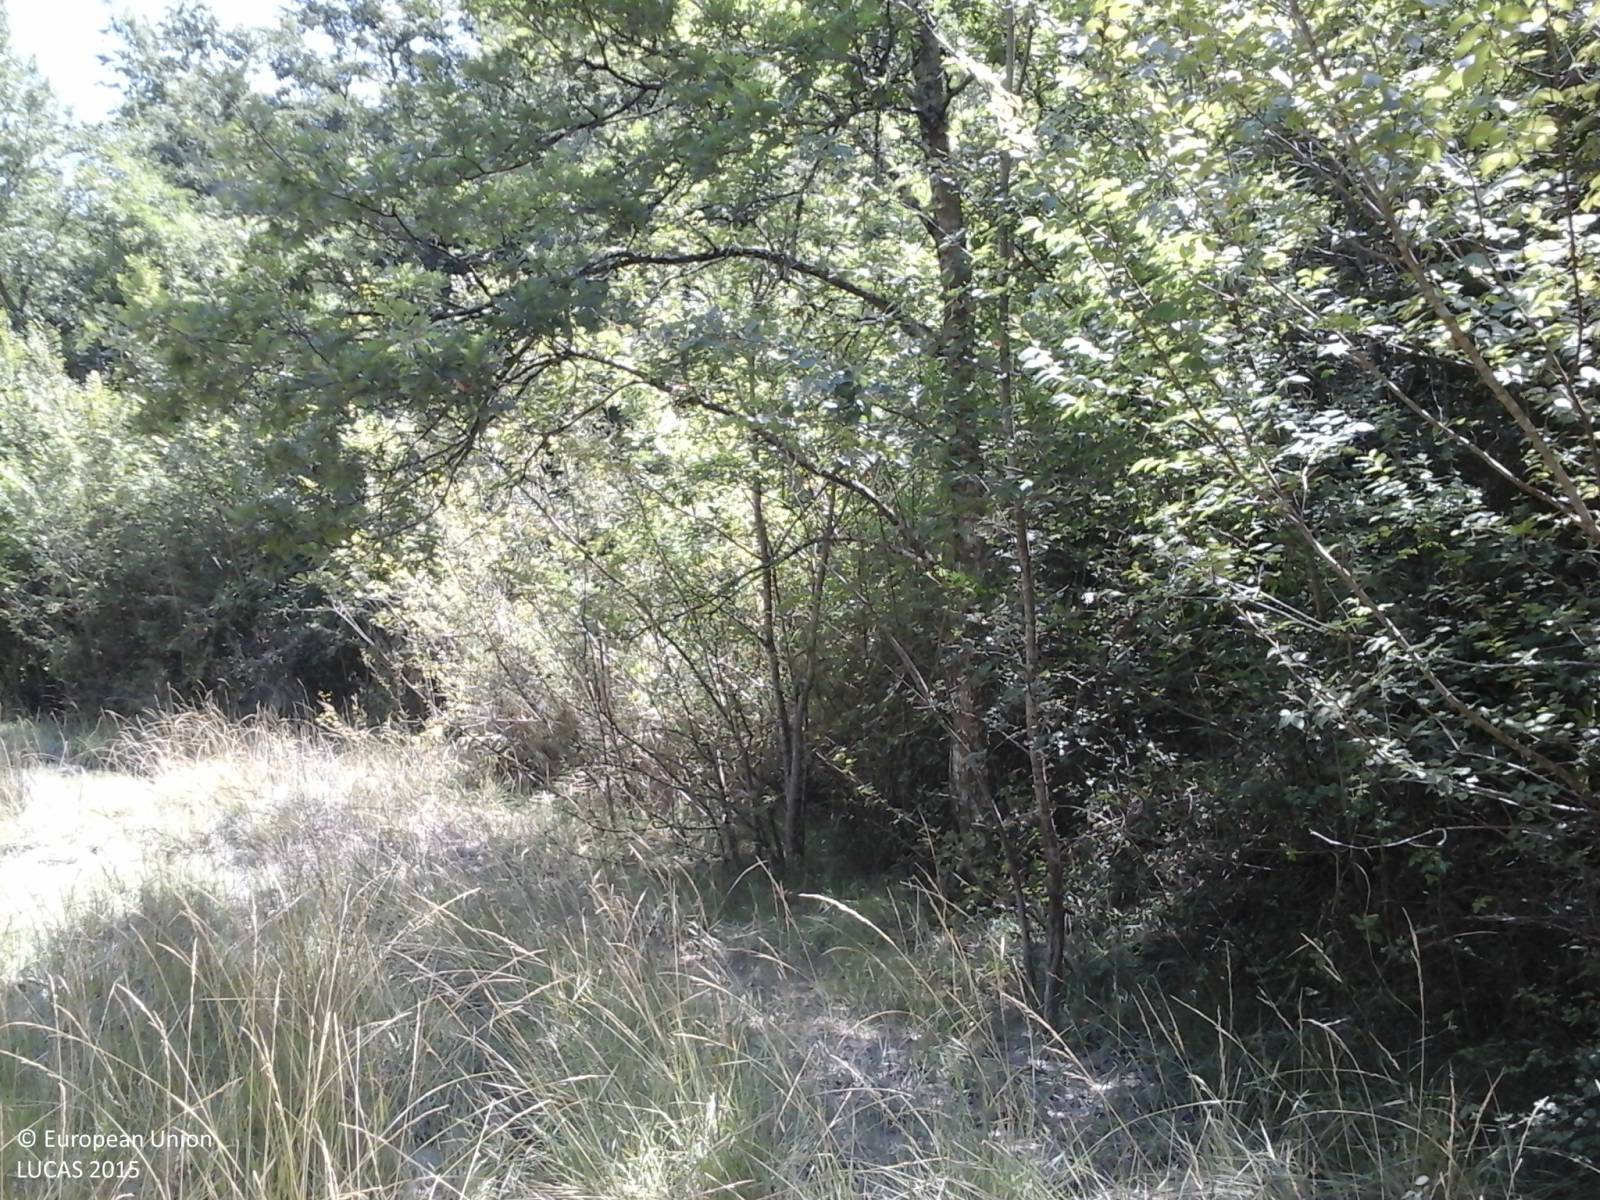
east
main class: Woodland
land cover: Broadleaved woodland
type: thermophilous deciduous forest
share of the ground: > 75 %
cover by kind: broadleaved forest trees 95 %, shrubs 5 %
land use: Forestry
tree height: > 5 m
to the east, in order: Broadleaved woodland
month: June
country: IT
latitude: 42.6126
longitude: 12.1750
